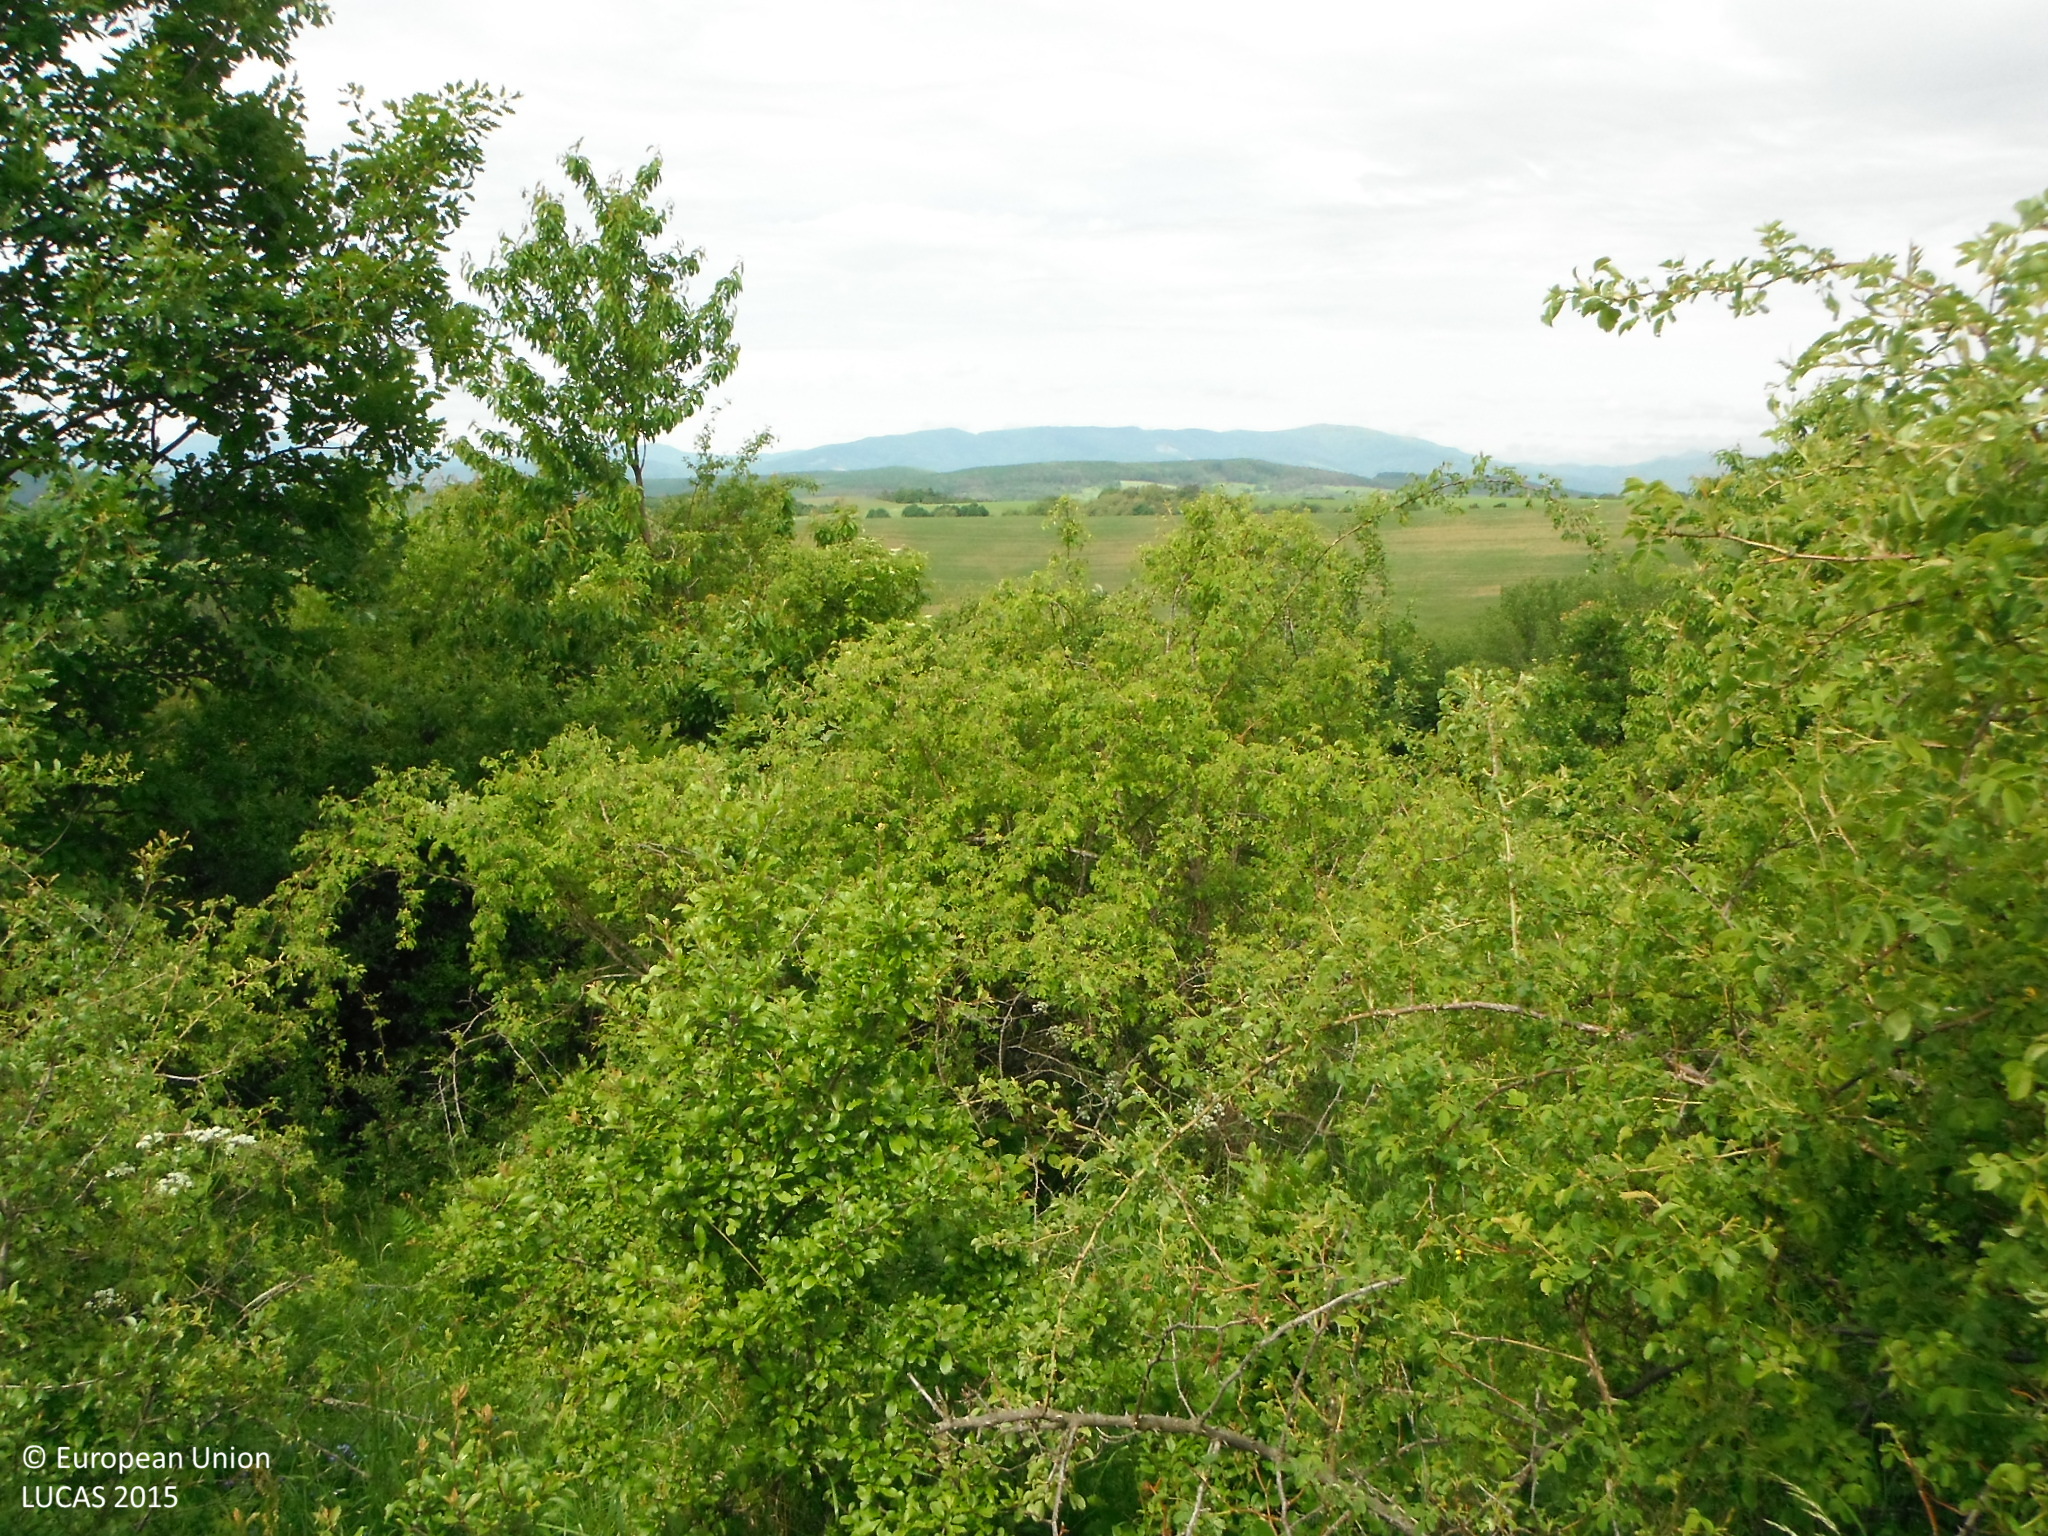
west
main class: Shrubland
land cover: Shrubland with sparse tree cover
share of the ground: > 75 %
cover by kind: shrubs 70 %, herbaceous plants 15 %, consolidated bare surface 10 %, broadleaved forest trees 5 %
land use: Semi-natural and natural areas not in use
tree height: < 5 m
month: May
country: SK
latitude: 48.7805
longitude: 18.7426
